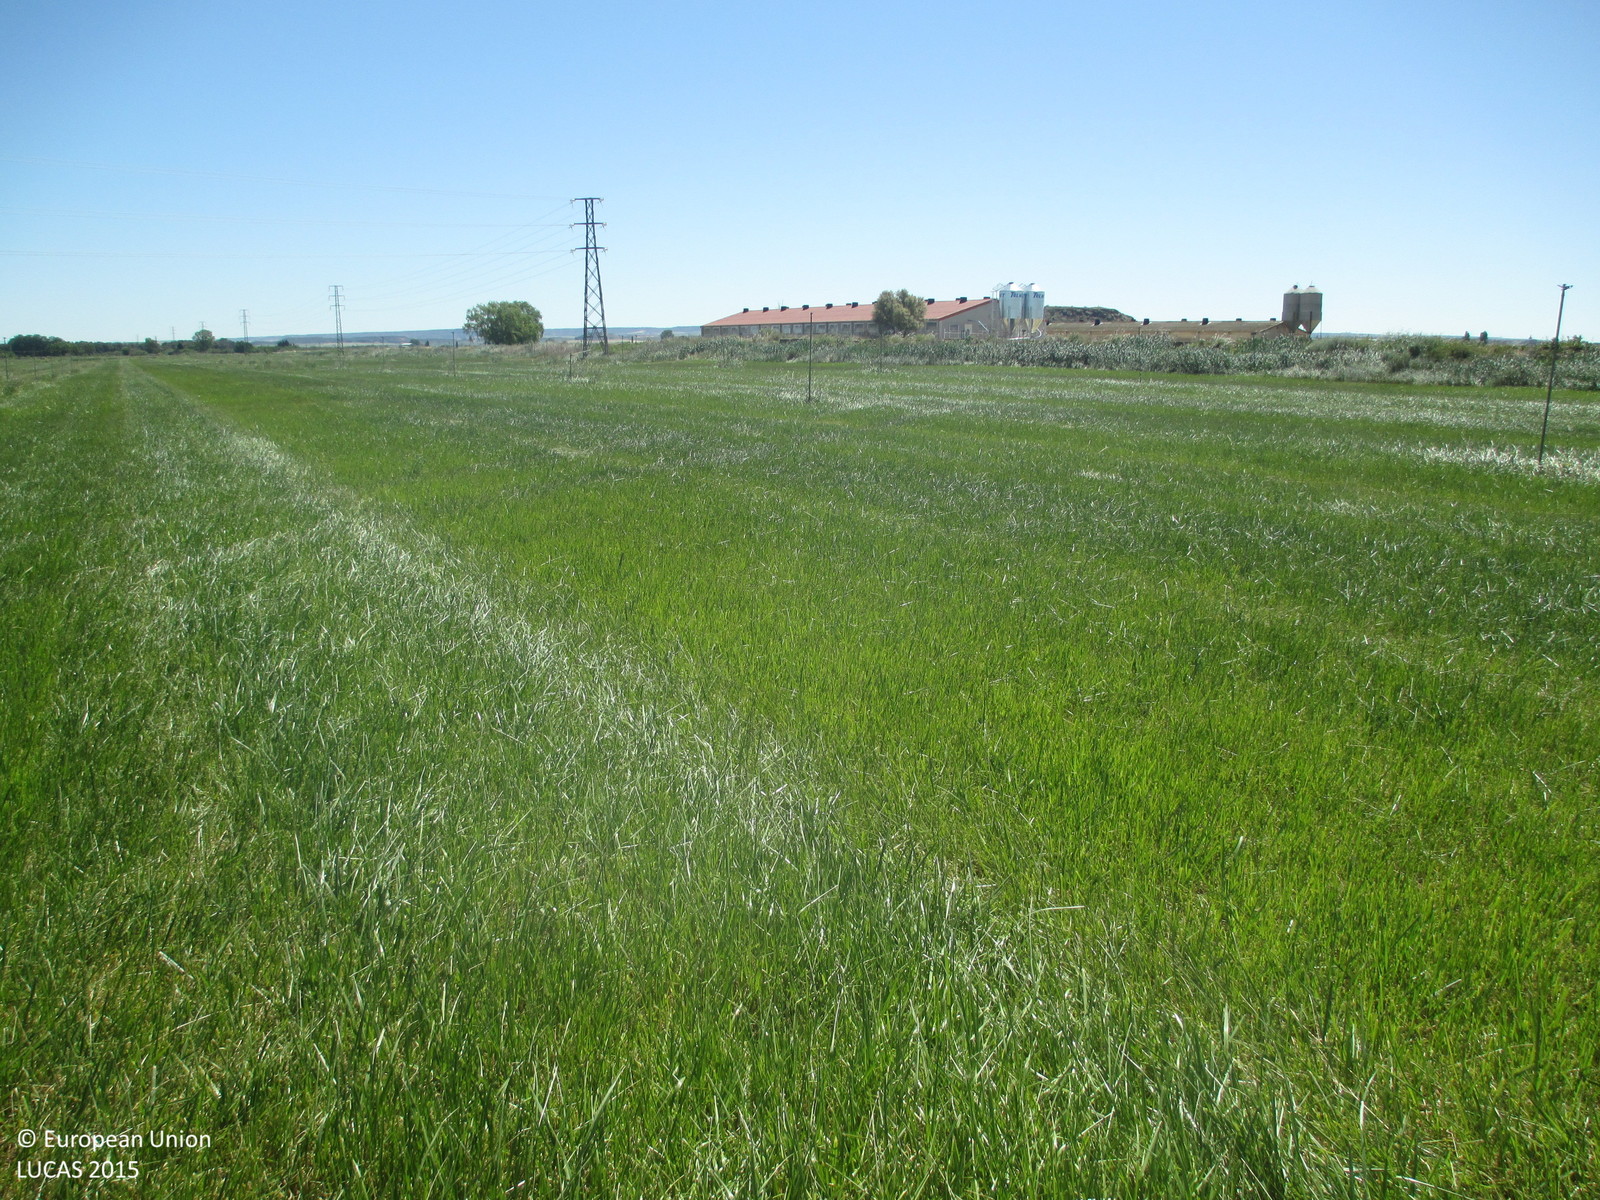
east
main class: Cropland
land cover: Temporary grasslands
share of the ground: > 75 %
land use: Agriculture (excluding fallow land and kitchen gardens)
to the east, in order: Temporary grasslands; Grass margins; Ditches and canals; Shruby margins; Paved roads, cycling and walking lanes; Shruby margins; Ditches and canals; Shruby margins; Artificial constructions in urban areas; Spontaneously vegetated surfaces; Ditches and canals; Grass margins; Tracks; Lucerne
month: May
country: ES
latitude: 41.8626
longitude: -0.2227
